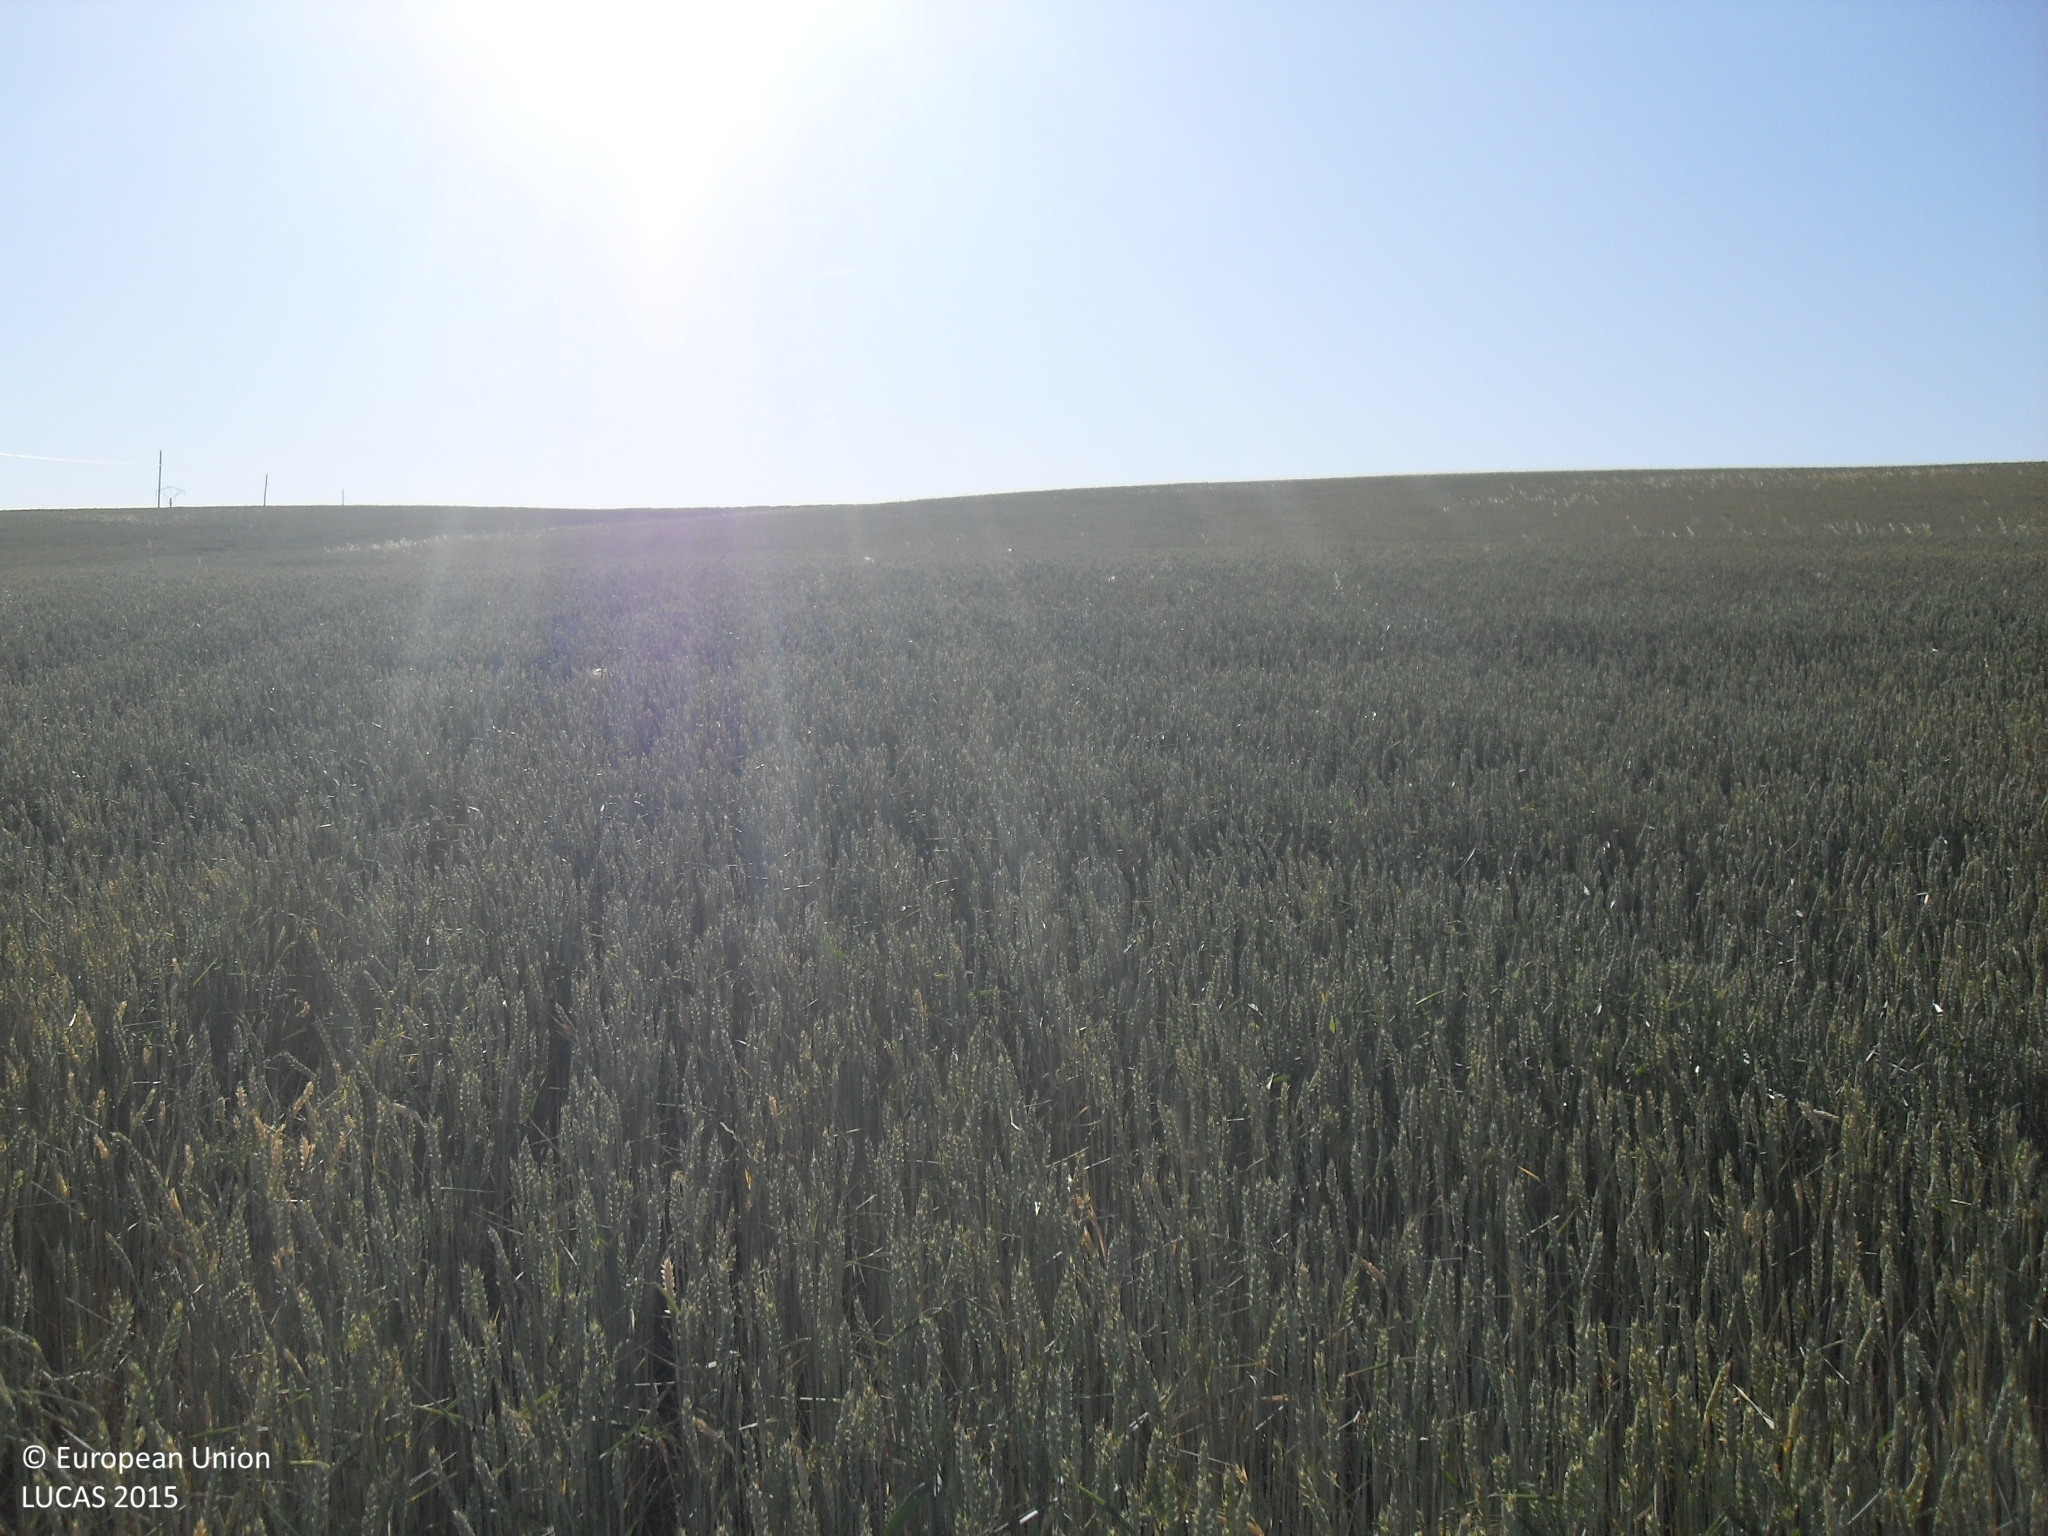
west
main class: Cropland
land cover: Common wheat
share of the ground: > 75 %
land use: Agriculture (excluding fallow land and kitchen gardens)
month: May
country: ES
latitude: 41.0452
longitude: -5.2869
